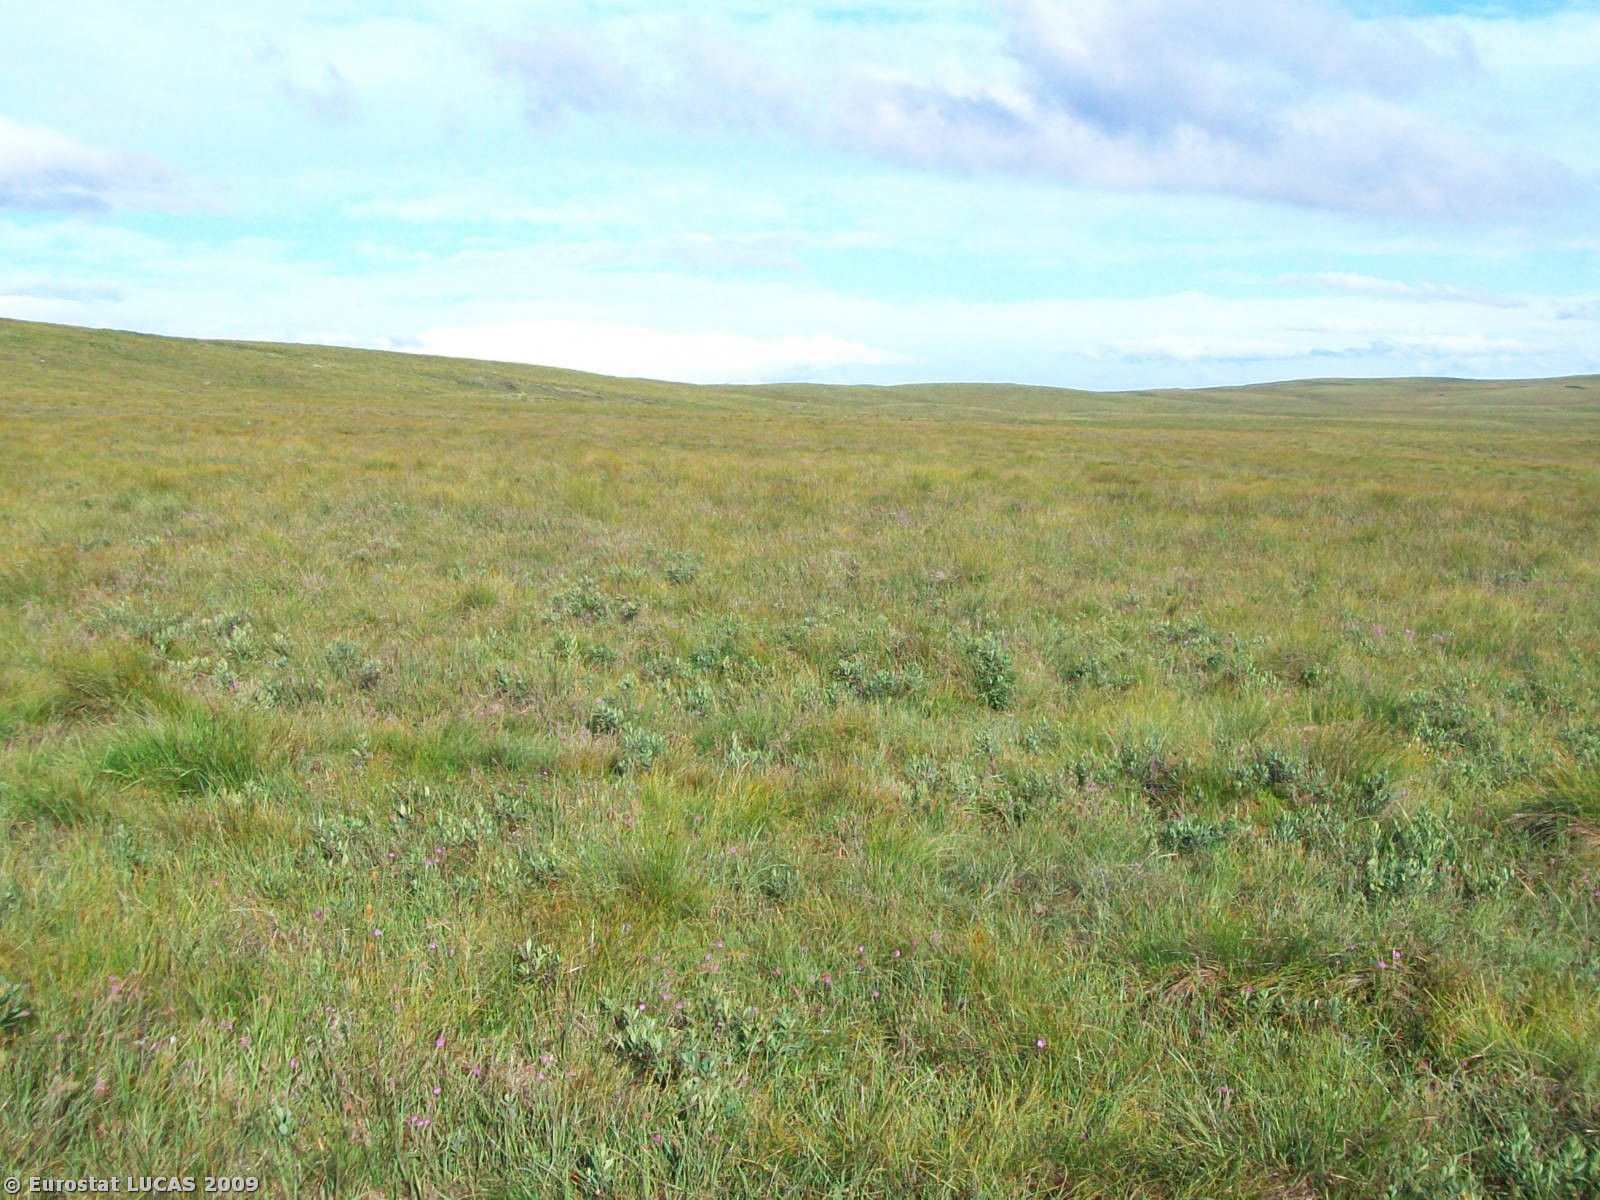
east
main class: Shrubland
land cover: Shrubland without tree cover
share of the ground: > 75 %
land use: Agriculture (excluding fallow land and kitchen gardens)
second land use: Forestry
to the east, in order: Shrubland without tree cover; Ditches and canals; Shrubland without tree cover
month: August
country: GB
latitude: 58.1372
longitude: -4.5419
